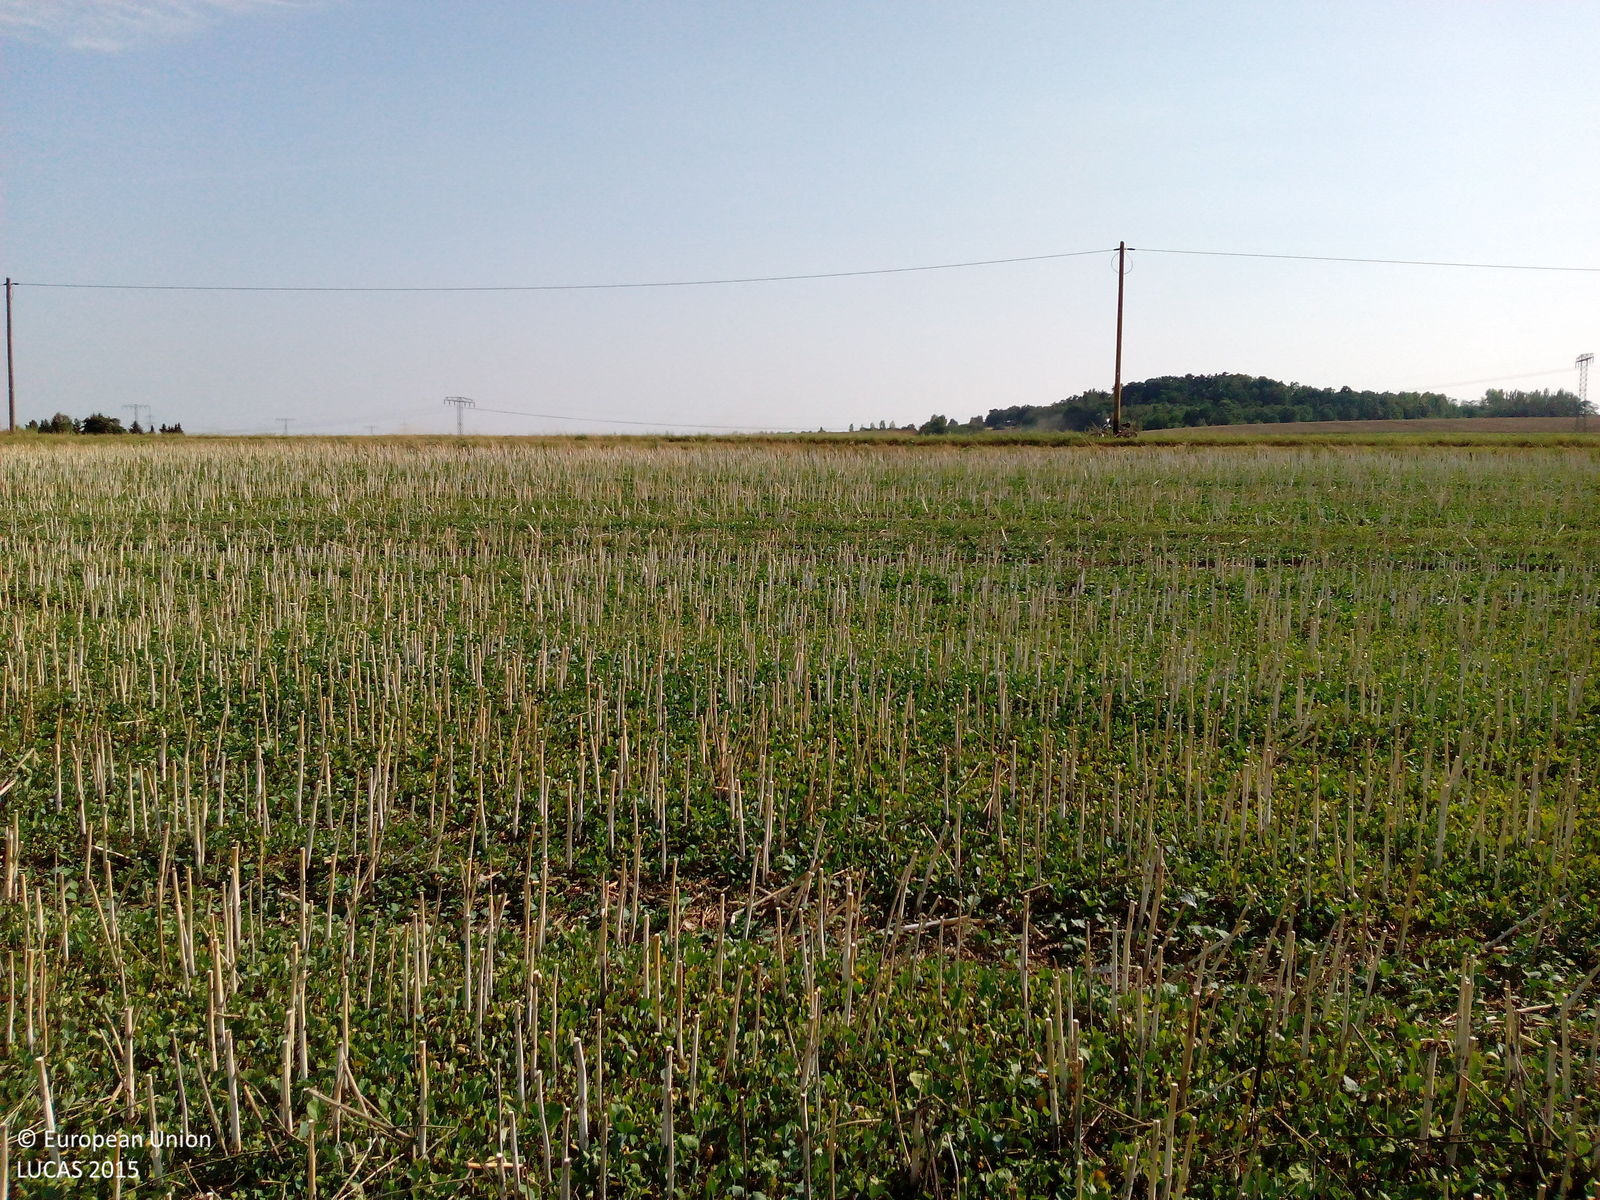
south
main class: Cropland
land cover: Rape and turnip rape
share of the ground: 10 - 25 %
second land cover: Other root crops
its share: 50 - 75 %
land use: Agriculture (excluding fallow land and kitchen gardens)
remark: Harvested field
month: August
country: DE
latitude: 51.8691
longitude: 11.0889
